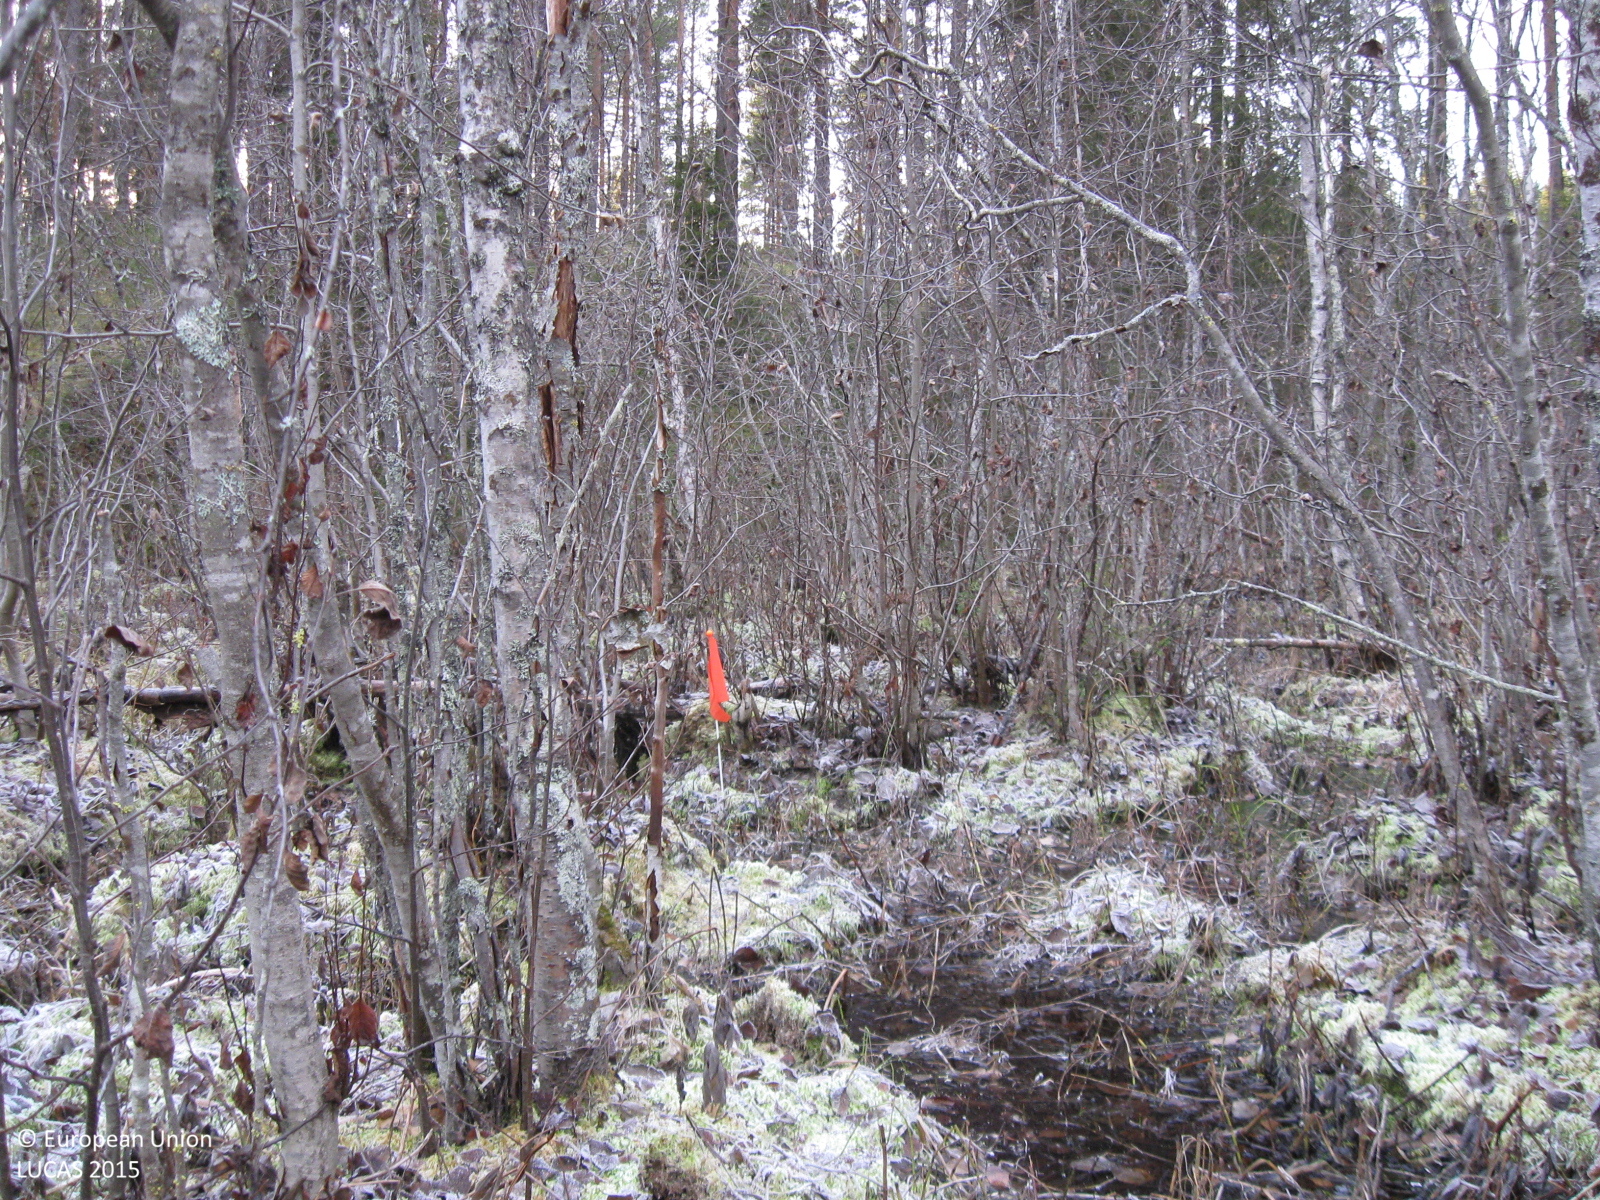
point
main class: Woodland
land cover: Broadleaved woodland
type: mire and swamp forests
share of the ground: > 75 %
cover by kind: broadleaved forest trees 75 %, herbaceous plants 10 %, lichens and mosses 10 %
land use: Semi-natural and natural areas not in use
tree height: < 5 m
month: October
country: SE
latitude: 66.1680
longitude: 21.6115
